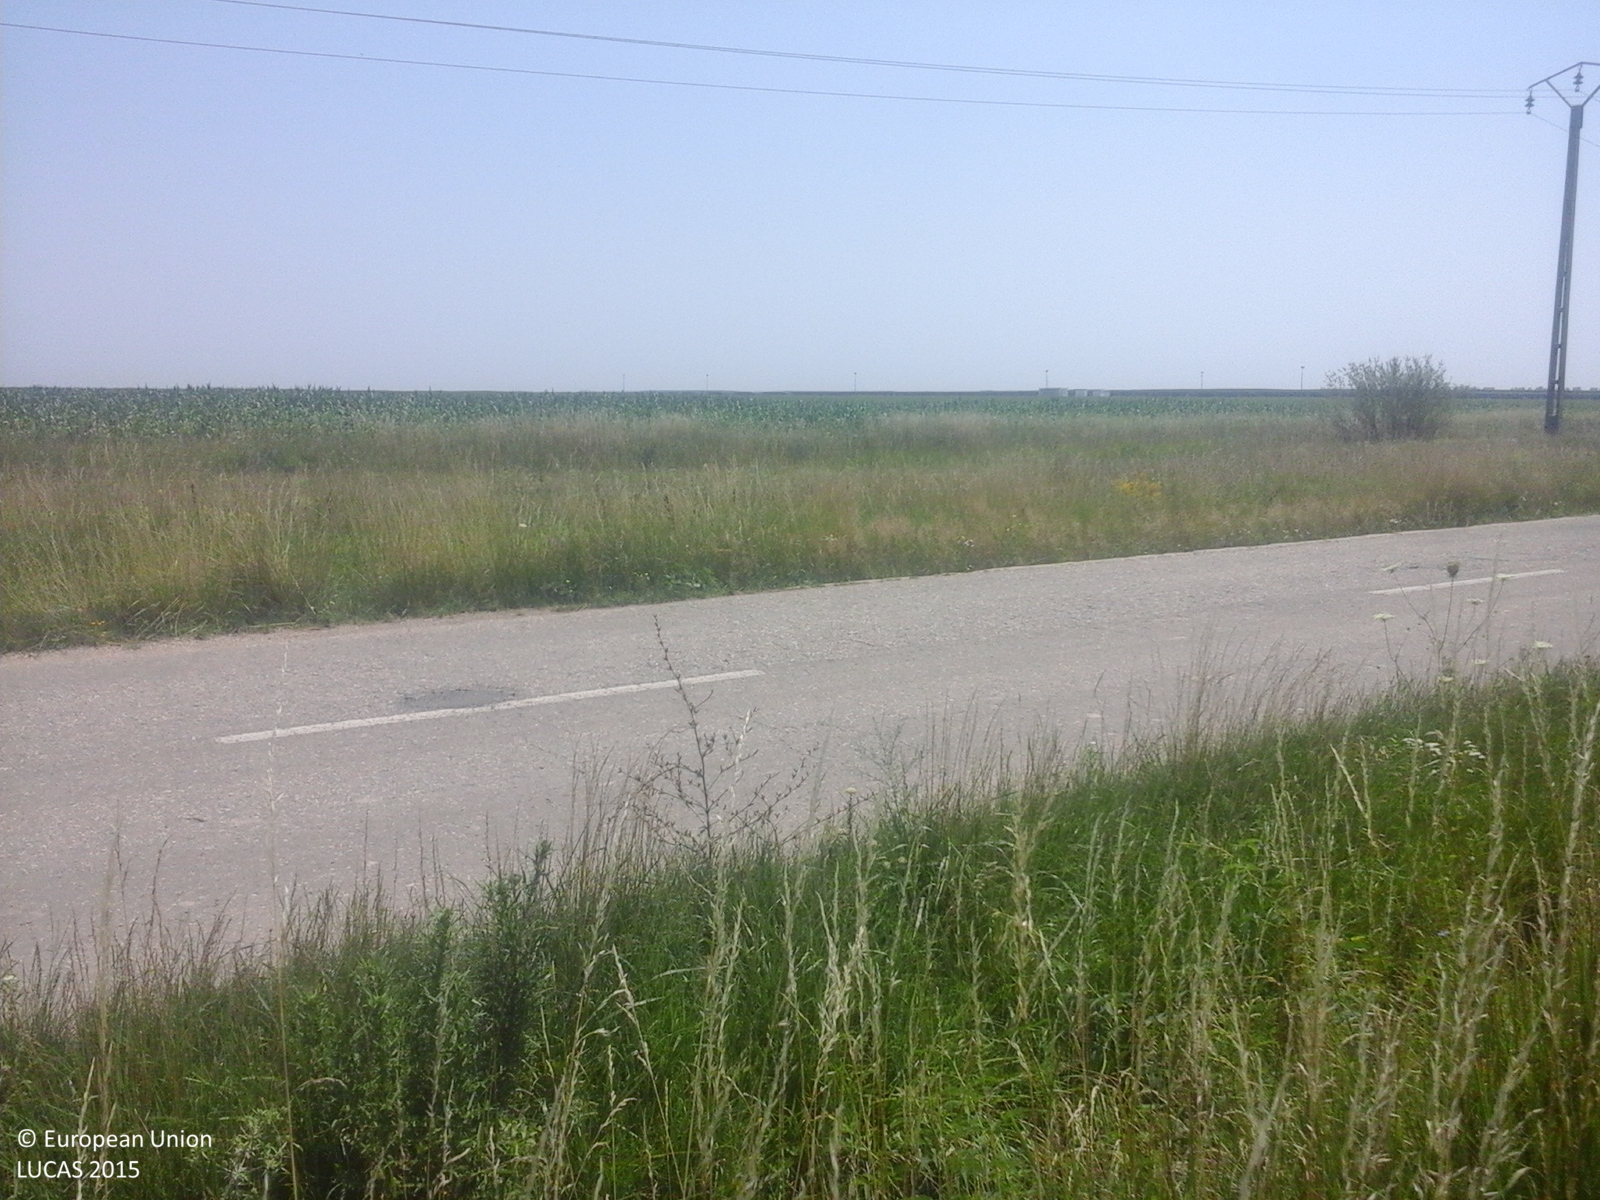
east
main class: Grassland
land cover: Grassland without tree/shrub cover
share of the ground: > 75 %
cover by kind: herbaceous plants 100 %
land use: Agriculture (excluding fallow land and kitchen gardens)
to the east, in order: Grassland without tree/shrub cover; Fences; Grassland without tree/shrub cover
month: July
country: RO
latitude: 44.6982
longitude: 25.0124
